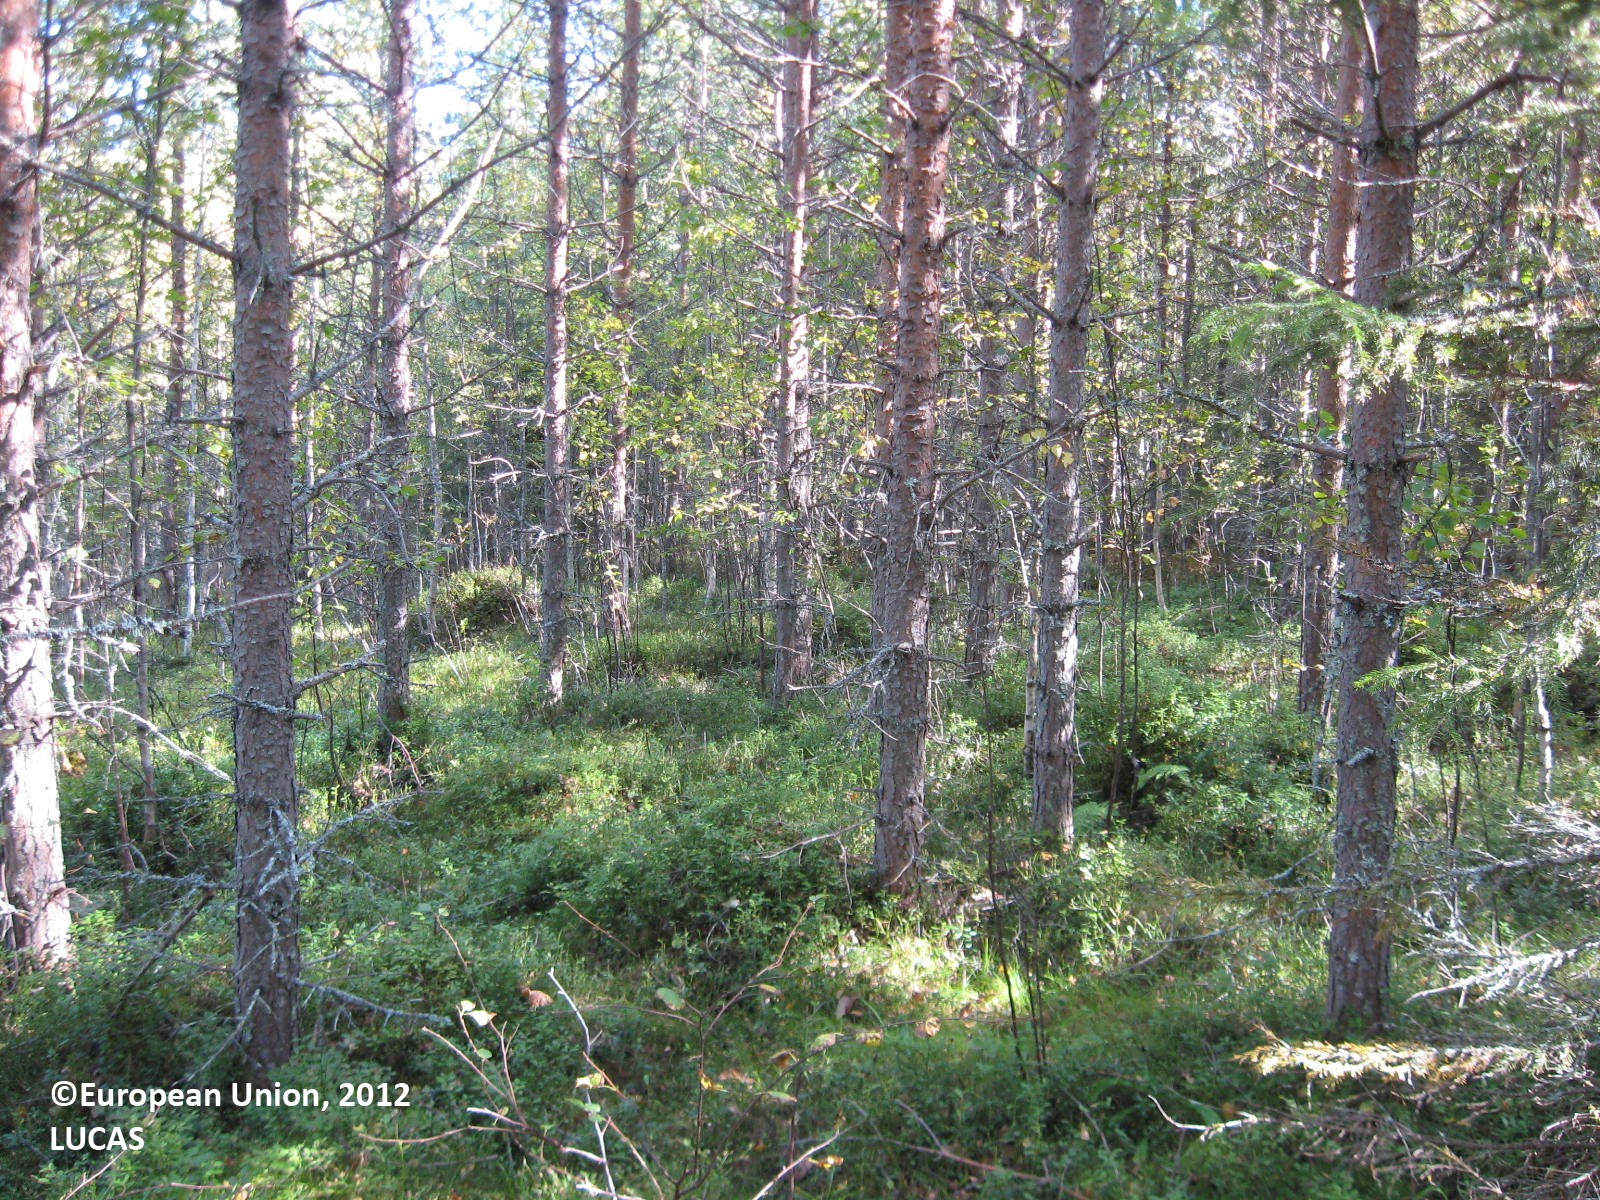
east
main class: Woodland
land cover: Pine dominated coniferous woodland
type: boreal forest
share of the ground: > 75 %
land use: Forestry
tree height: > 5 m
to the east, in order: Pine dominated coniferous woodland; Ditches and canals; Other mixed woodland; Ditches and canals; Pine dominated coniferous woodland; Ditches and canals; Other coniferous woodland; Ditches and canals; Spruce dominated coniferous woodland; Other mixed woodland; Ditches and canals; Other mixed woodland
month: August
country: FI
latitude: 63.8021
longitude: 29.9556
